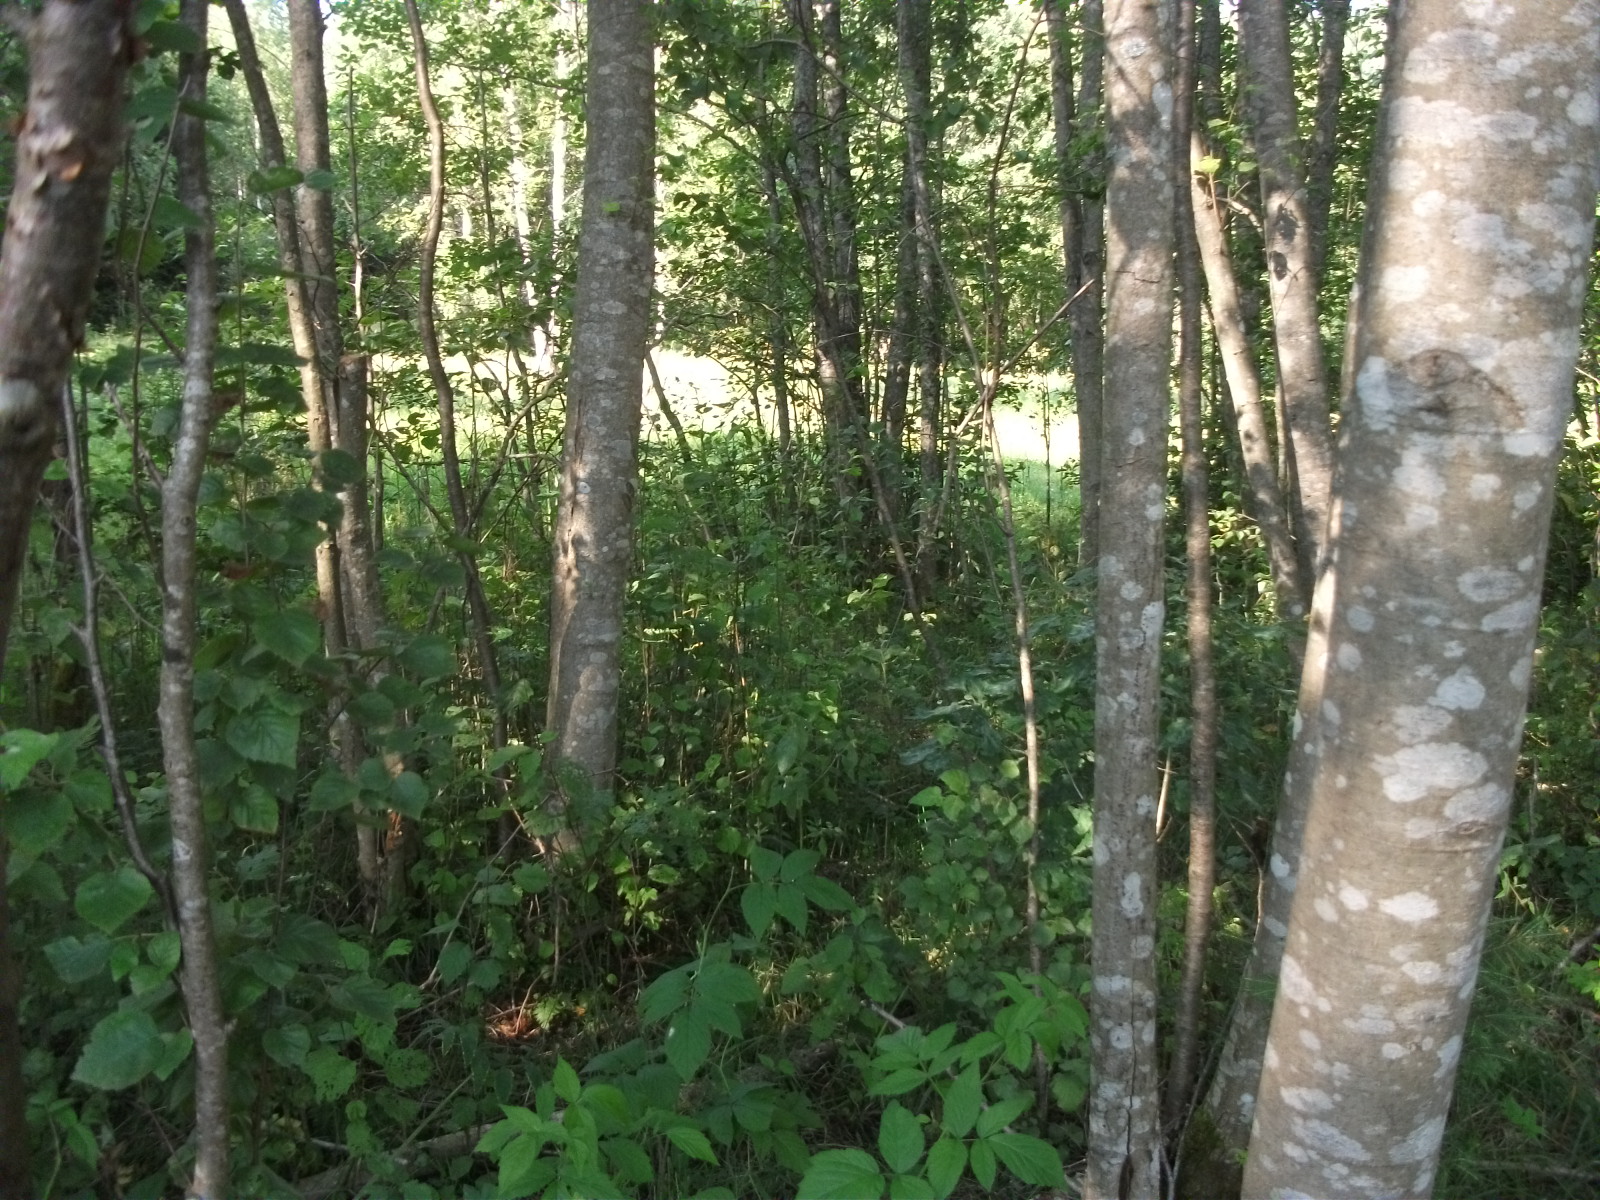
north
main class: Woodland
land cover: Broadleaved woodland
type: non-riverine alder, birch or aspen forest
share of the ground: > 75 %
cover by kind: broadleaved forest trees 85 %, herbaceous plants 10 %, shrubs 5 %
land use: Agriculture (excluding fallow land and kitchen gardens)
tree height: > 5 m
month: August
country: LV
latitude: 56.8061
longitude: 25.7326
